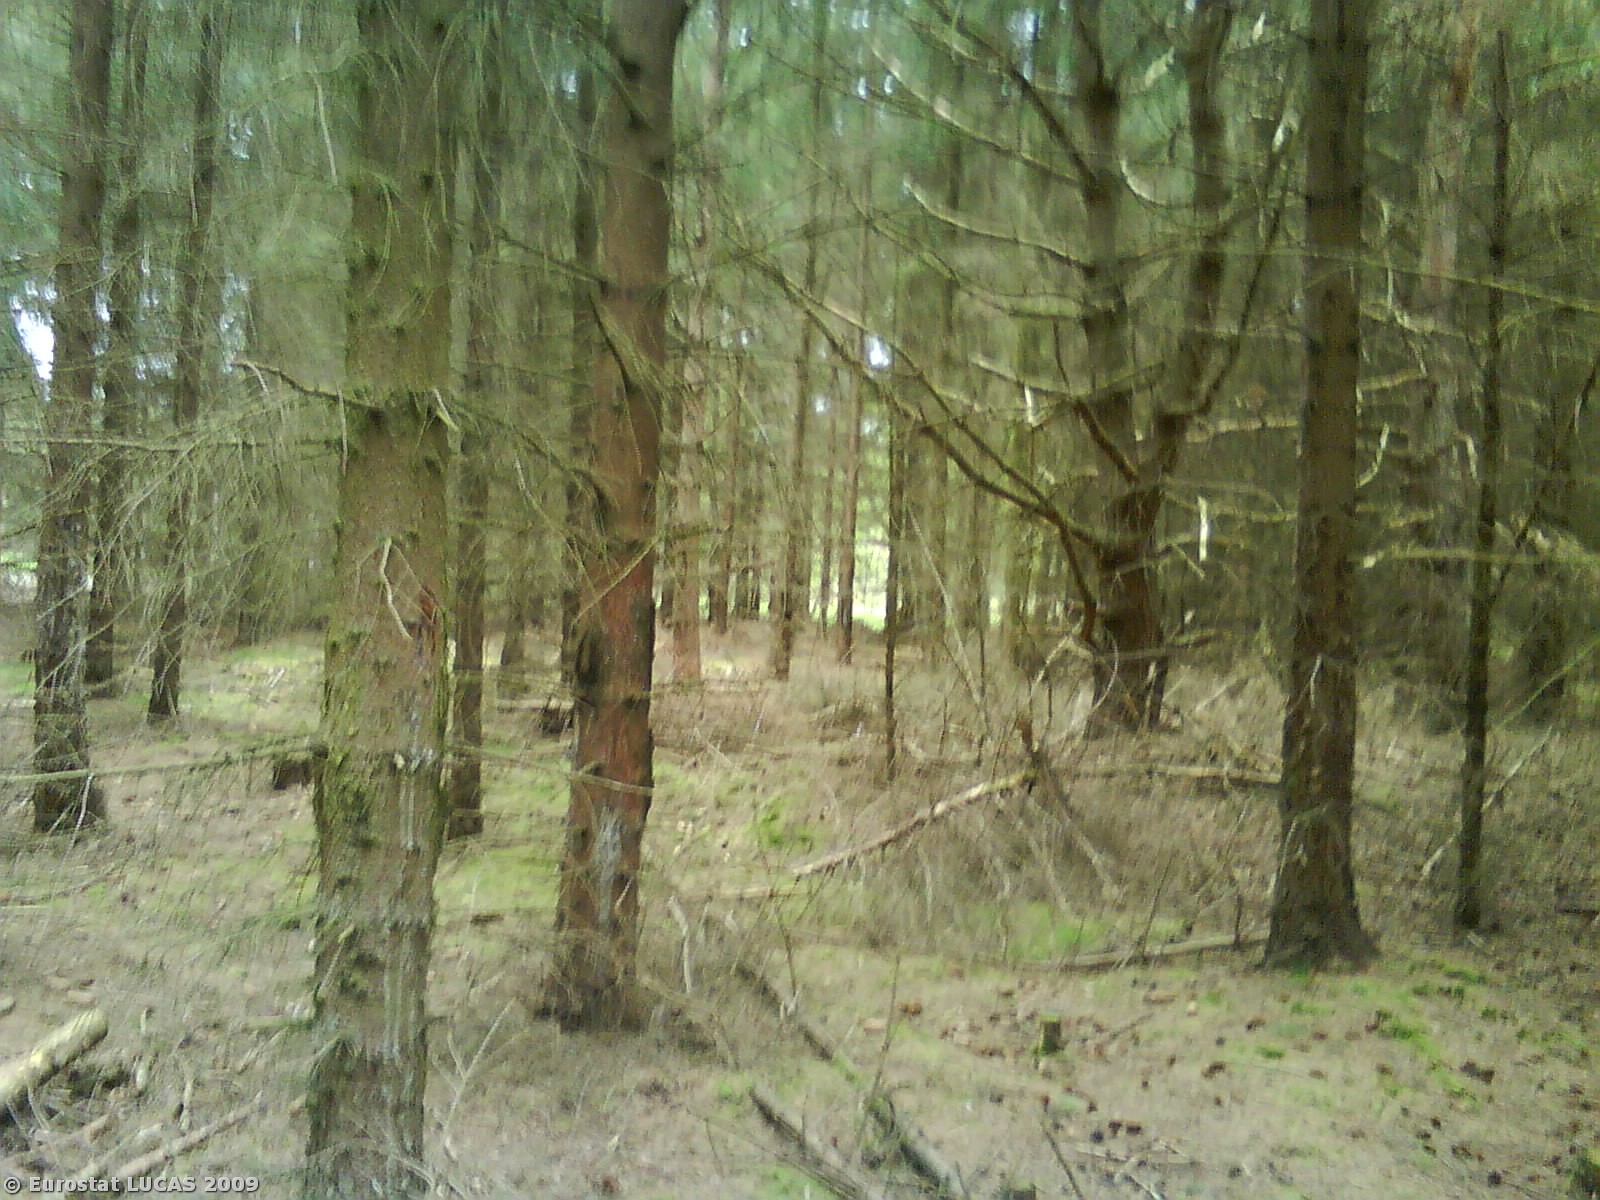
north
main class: Woodland
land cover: Coniferous woodland
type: hemiboreal forest and nemoral coniferous forest and mixed broadleaved-coniferous forest
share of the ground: 25 - 50 %
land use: Forestry
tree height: > 5 m
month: May
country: DK
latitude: 56.5091
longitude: 10.7627
